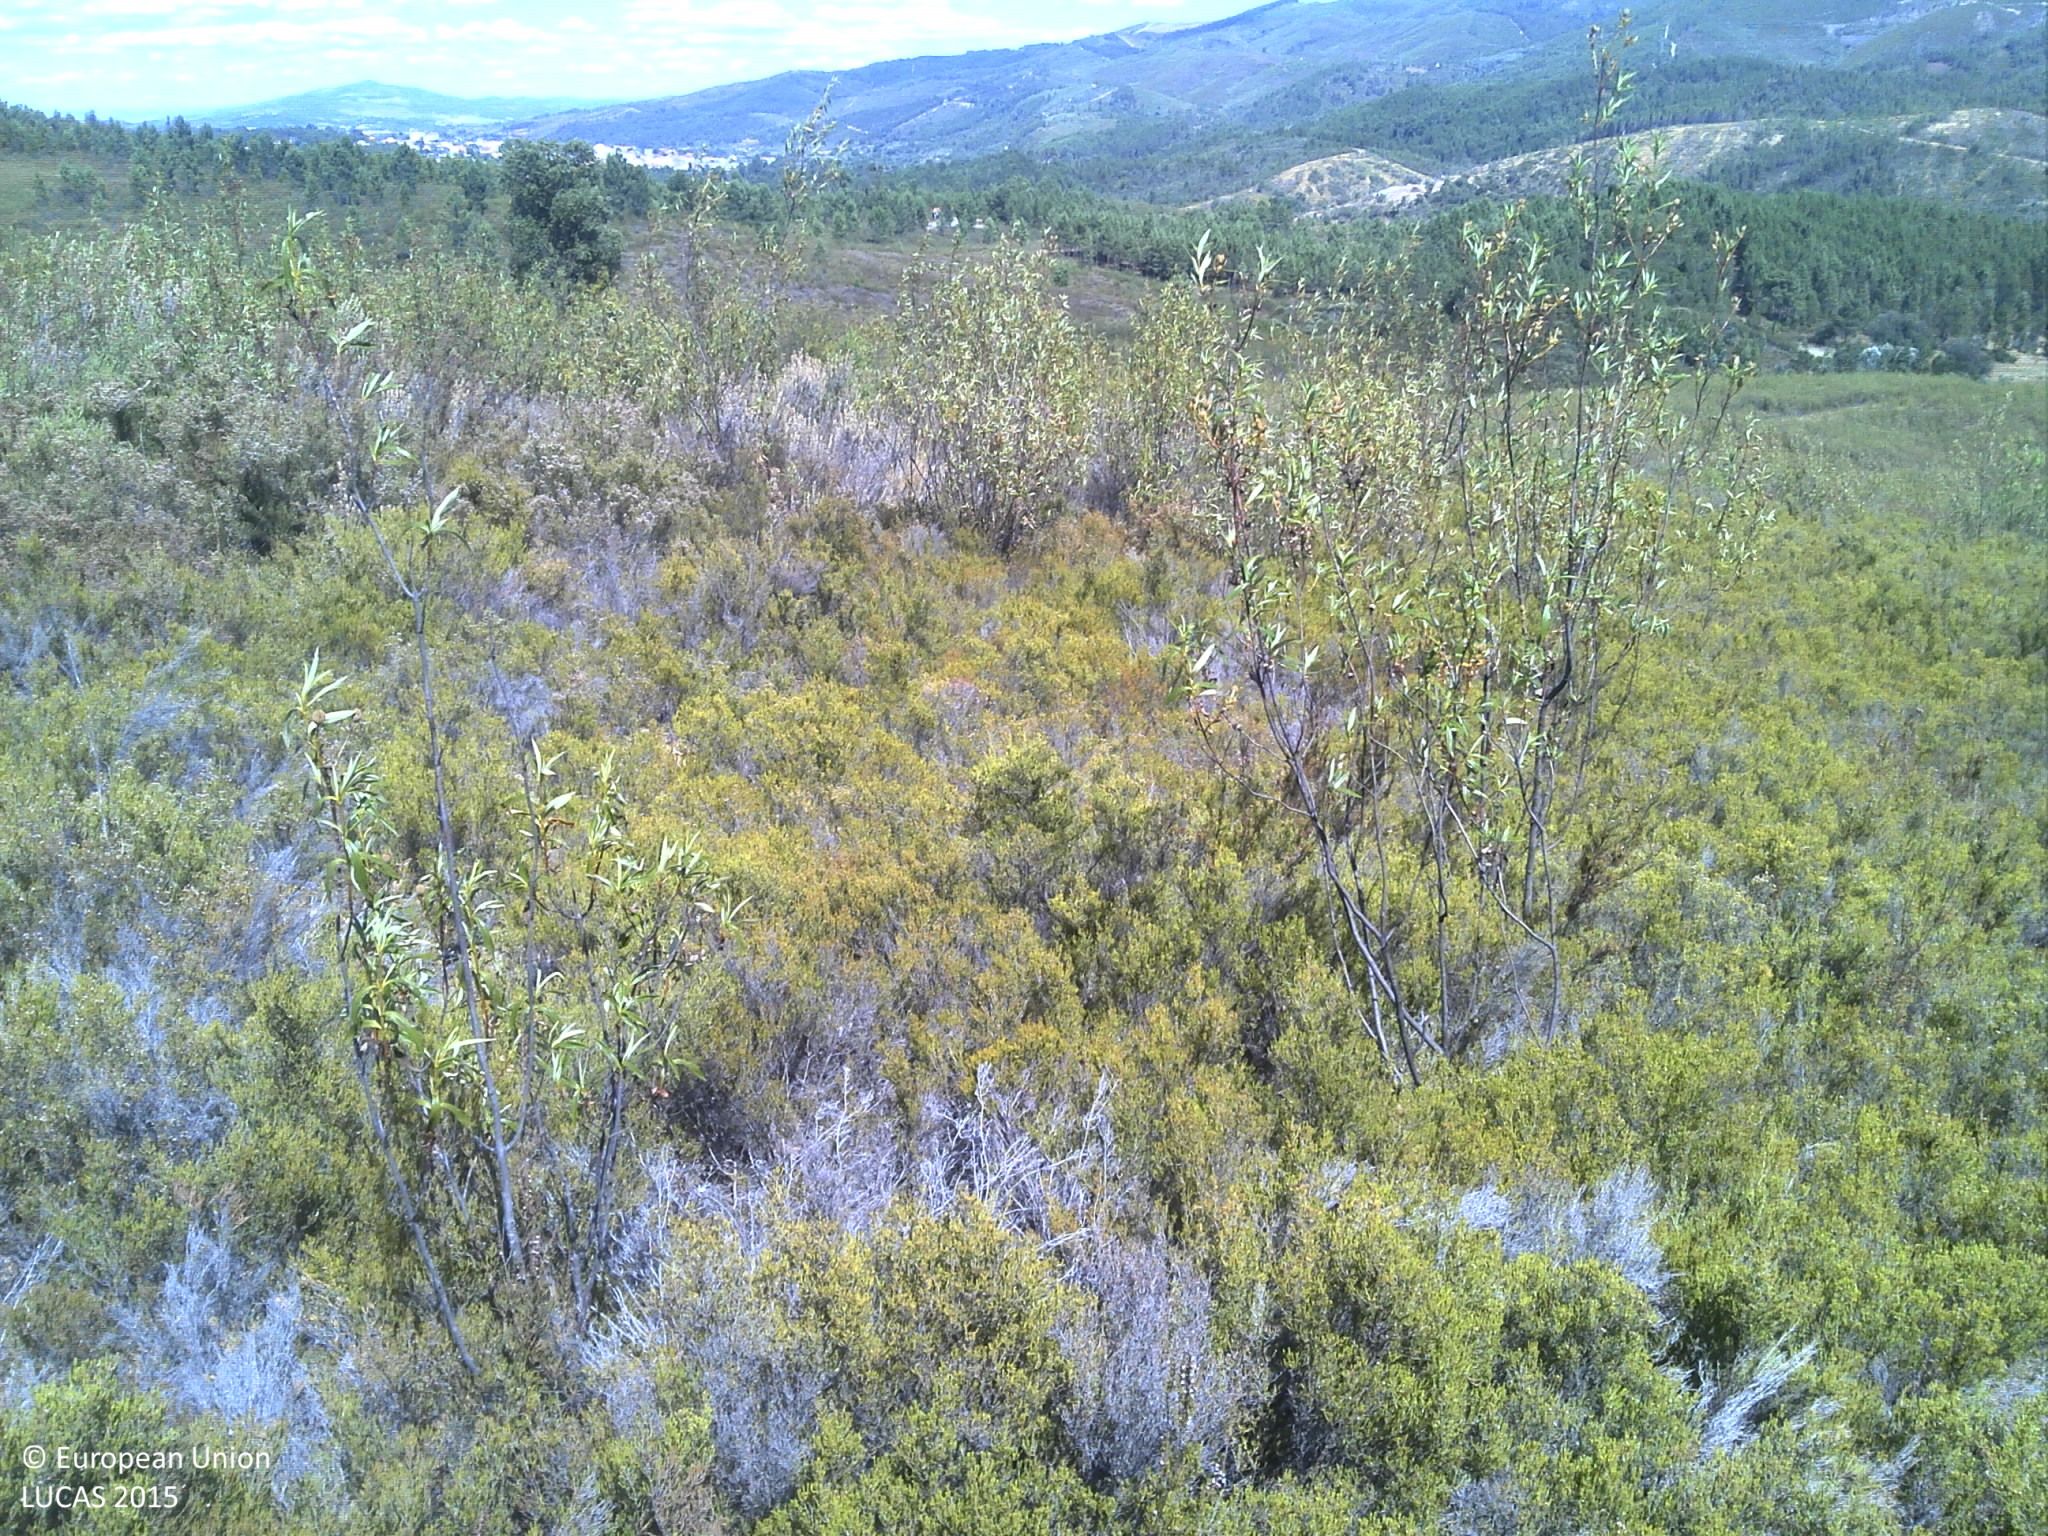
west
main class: Shrubland
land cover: Shrubland without tree cover
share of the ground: > 75 %
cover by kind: shrubs 80 %, unconsolidated bare surface 20 %
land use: Abandoned areas
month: July
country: PT
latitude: 40.1687
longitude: -7.6399
